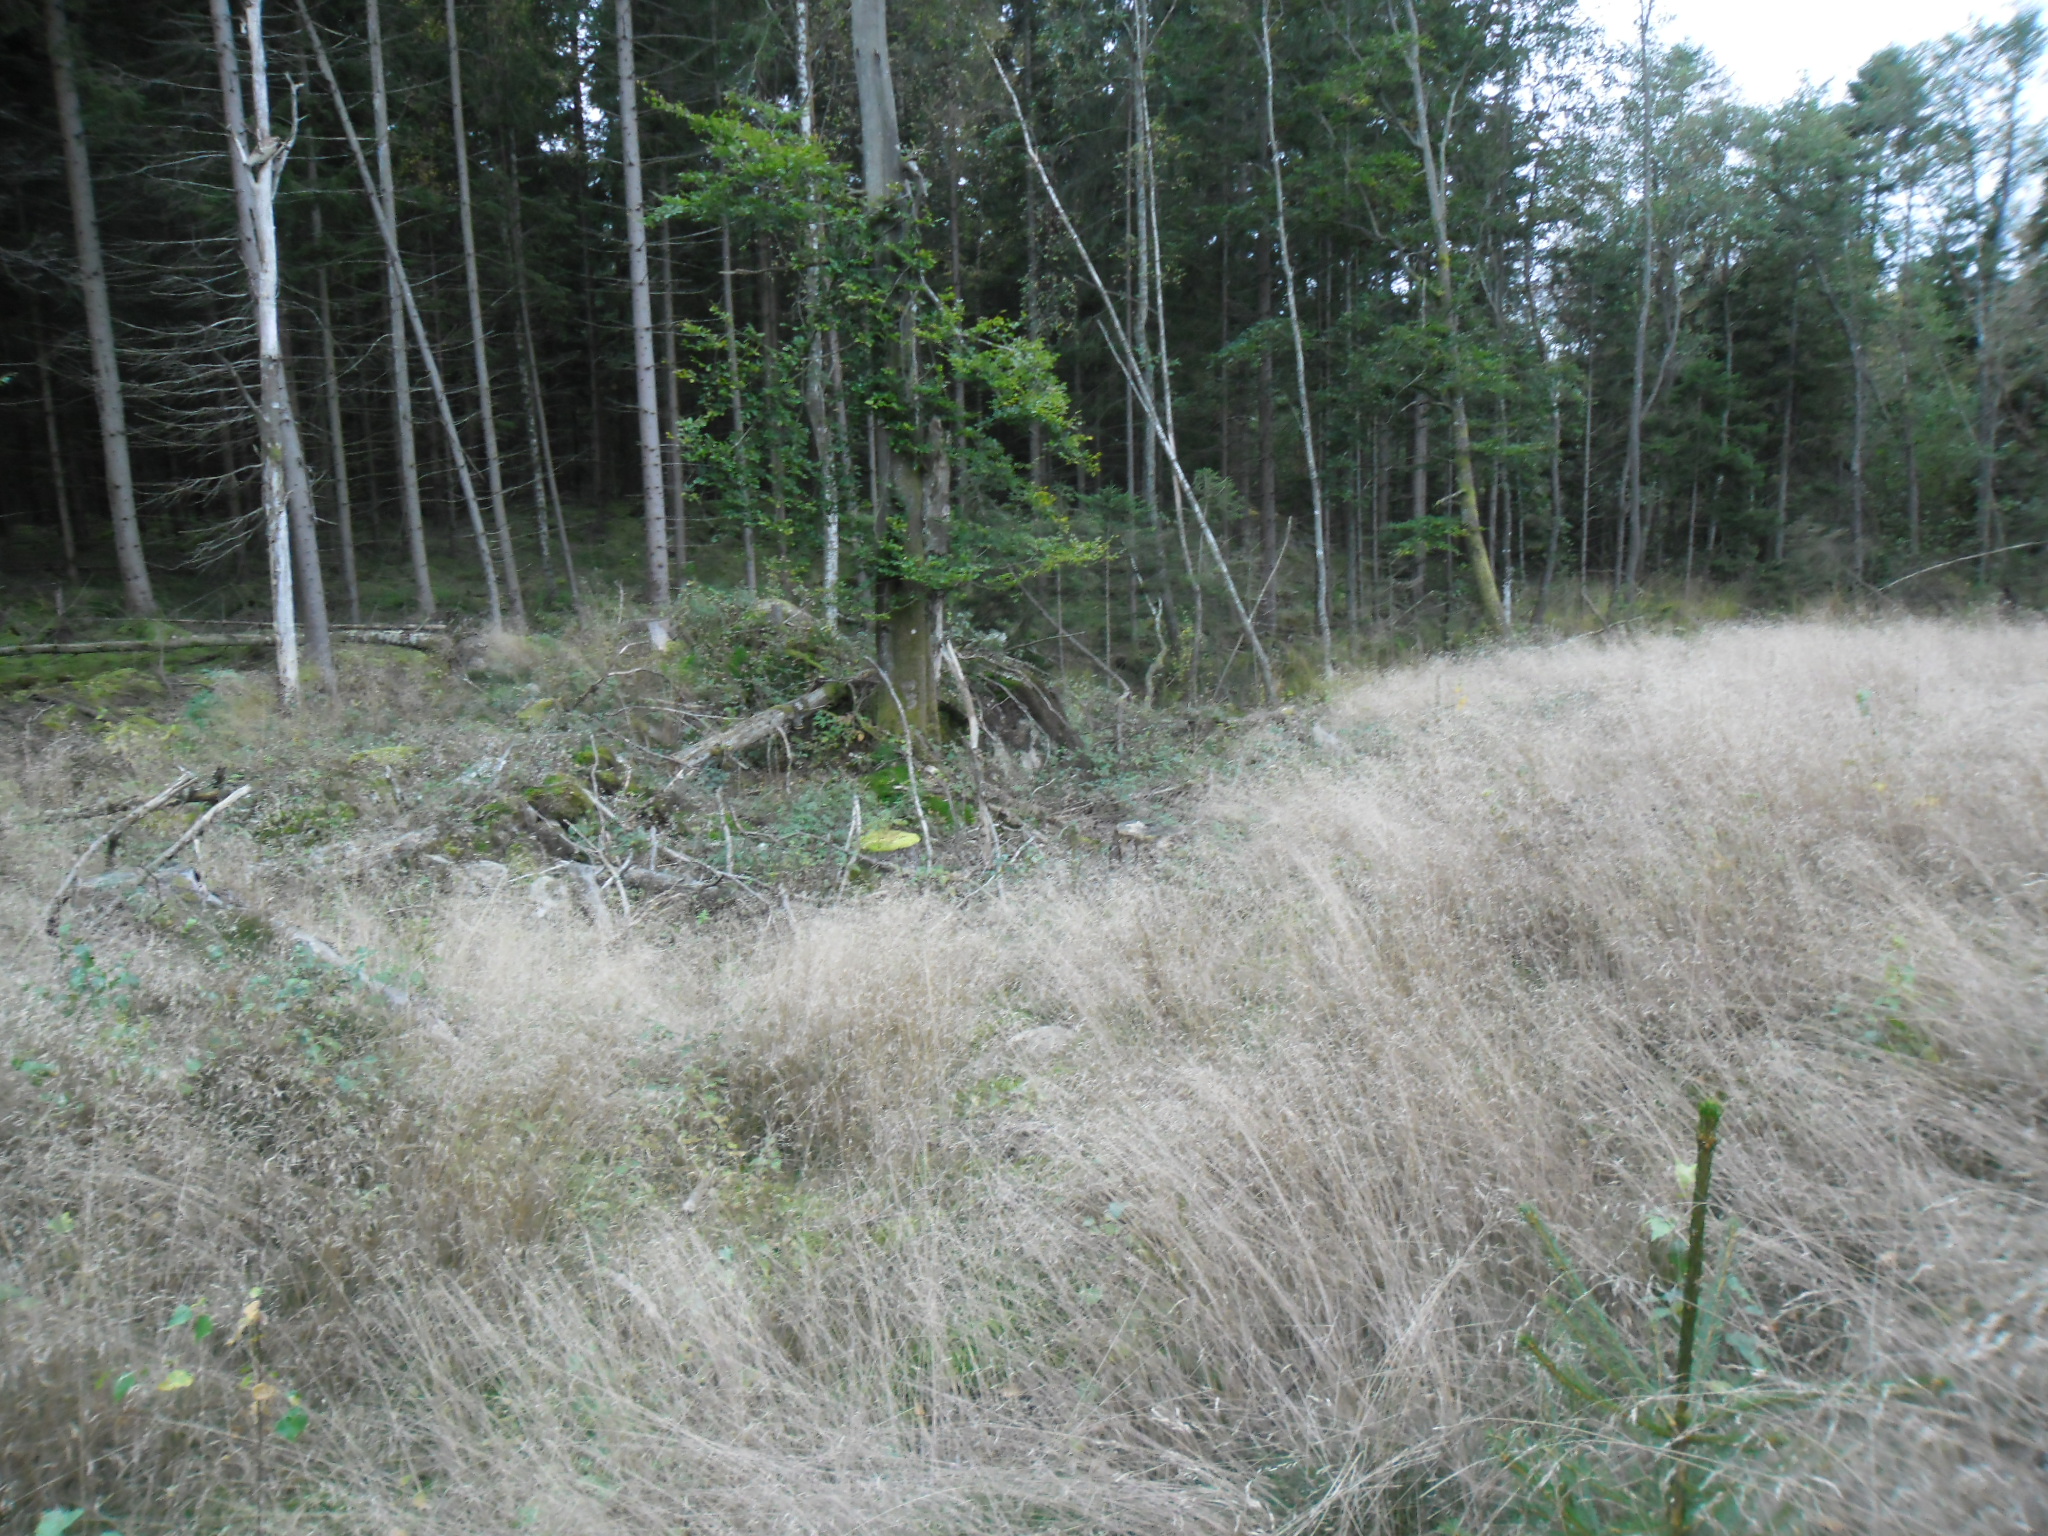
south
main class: Woodland
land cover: Spruce dominated coniferous woodland
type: boreal forest
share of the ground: > 75 %
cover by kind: coniferous forest trees 100 %
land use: Forestry
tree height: > 5 m
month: October
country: SE
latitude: 56.3674
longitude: 13.7368
